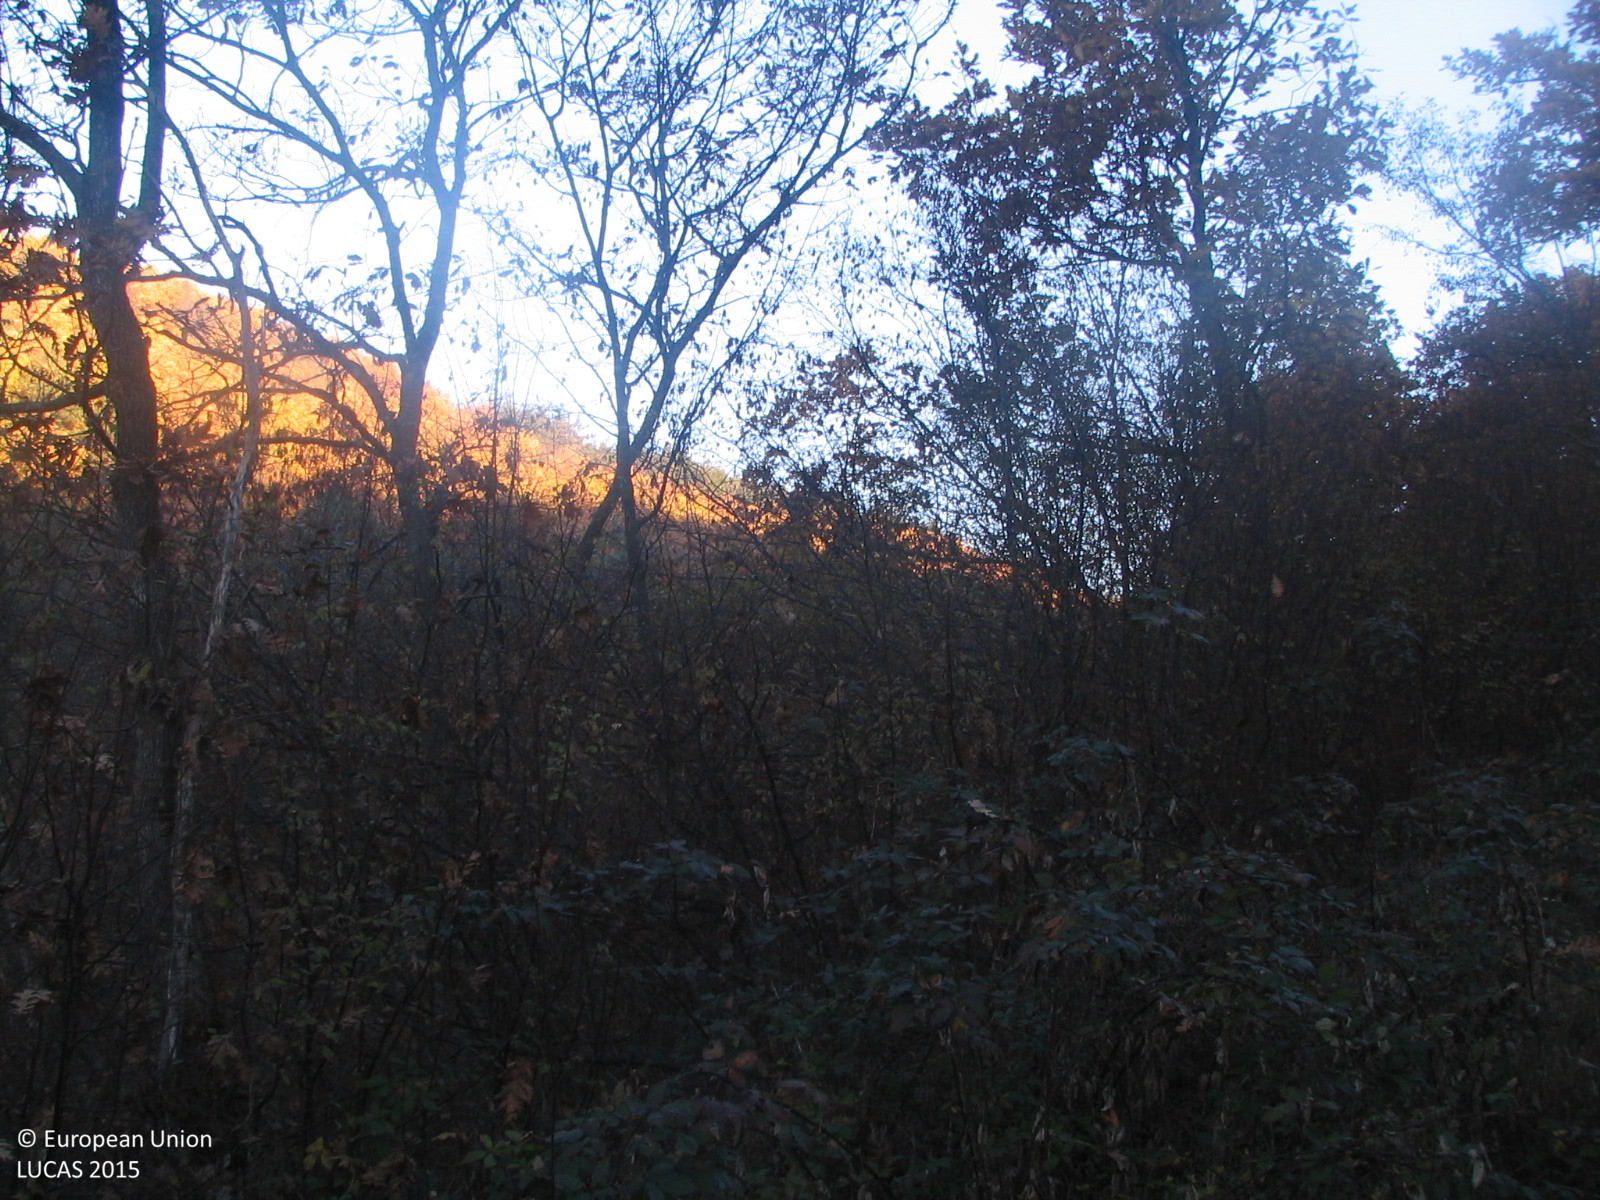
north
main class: Woodland
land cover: Broadleaved woodland
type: acidophilous oak and oak-birch forest
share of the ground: > 75 %
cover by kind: broadleaved forest trees 90 %, shrubs 5 %, herbaceous plants 5 %
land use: Forestry
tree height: > 5 m
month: November
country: BG
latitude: 42.9923
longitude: 23.7438
